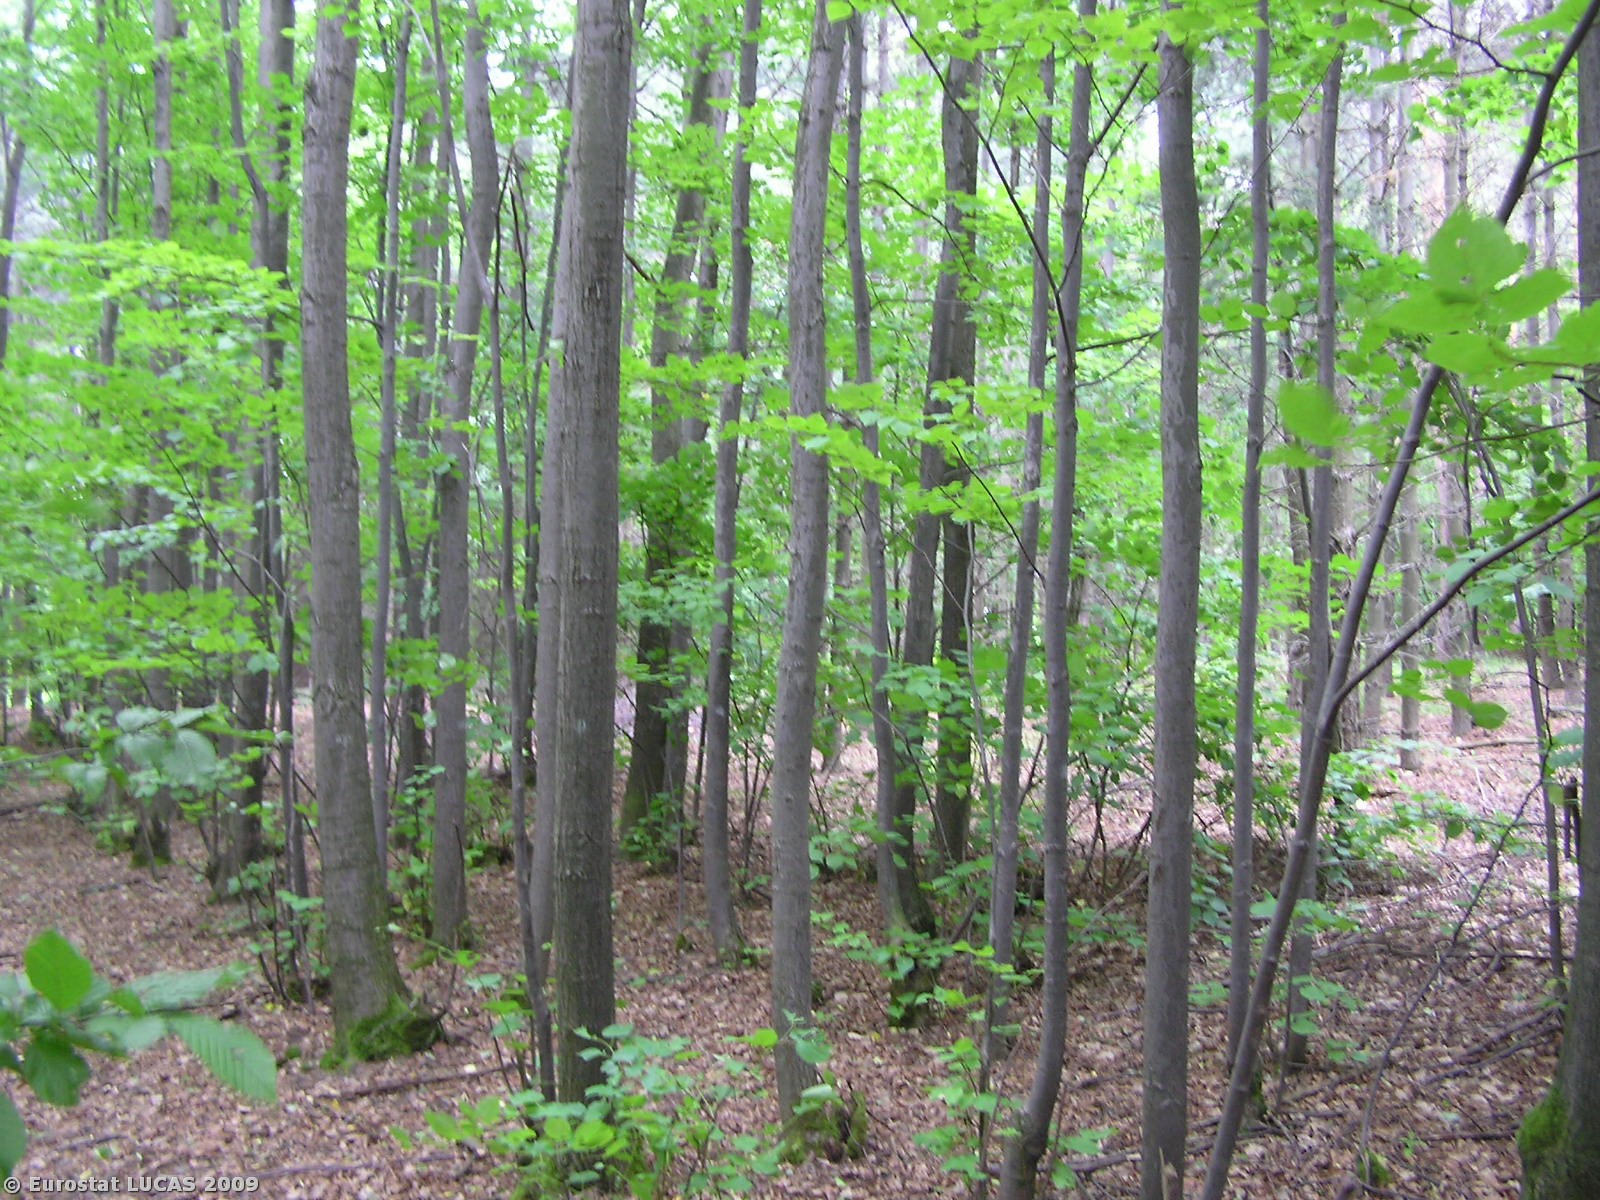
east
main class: Woodland
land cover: Broadleaved woodland
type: beech forest
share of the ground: > 75 %
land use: Forestry
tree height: > 5 m
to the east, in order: Broadleaved woodland; Mixed woodland; Grassland without tree/shrub cover; Coniferous woodland; Broadleaved woodland
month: June
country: CZ
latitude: 50.2160
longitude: 17.6511
